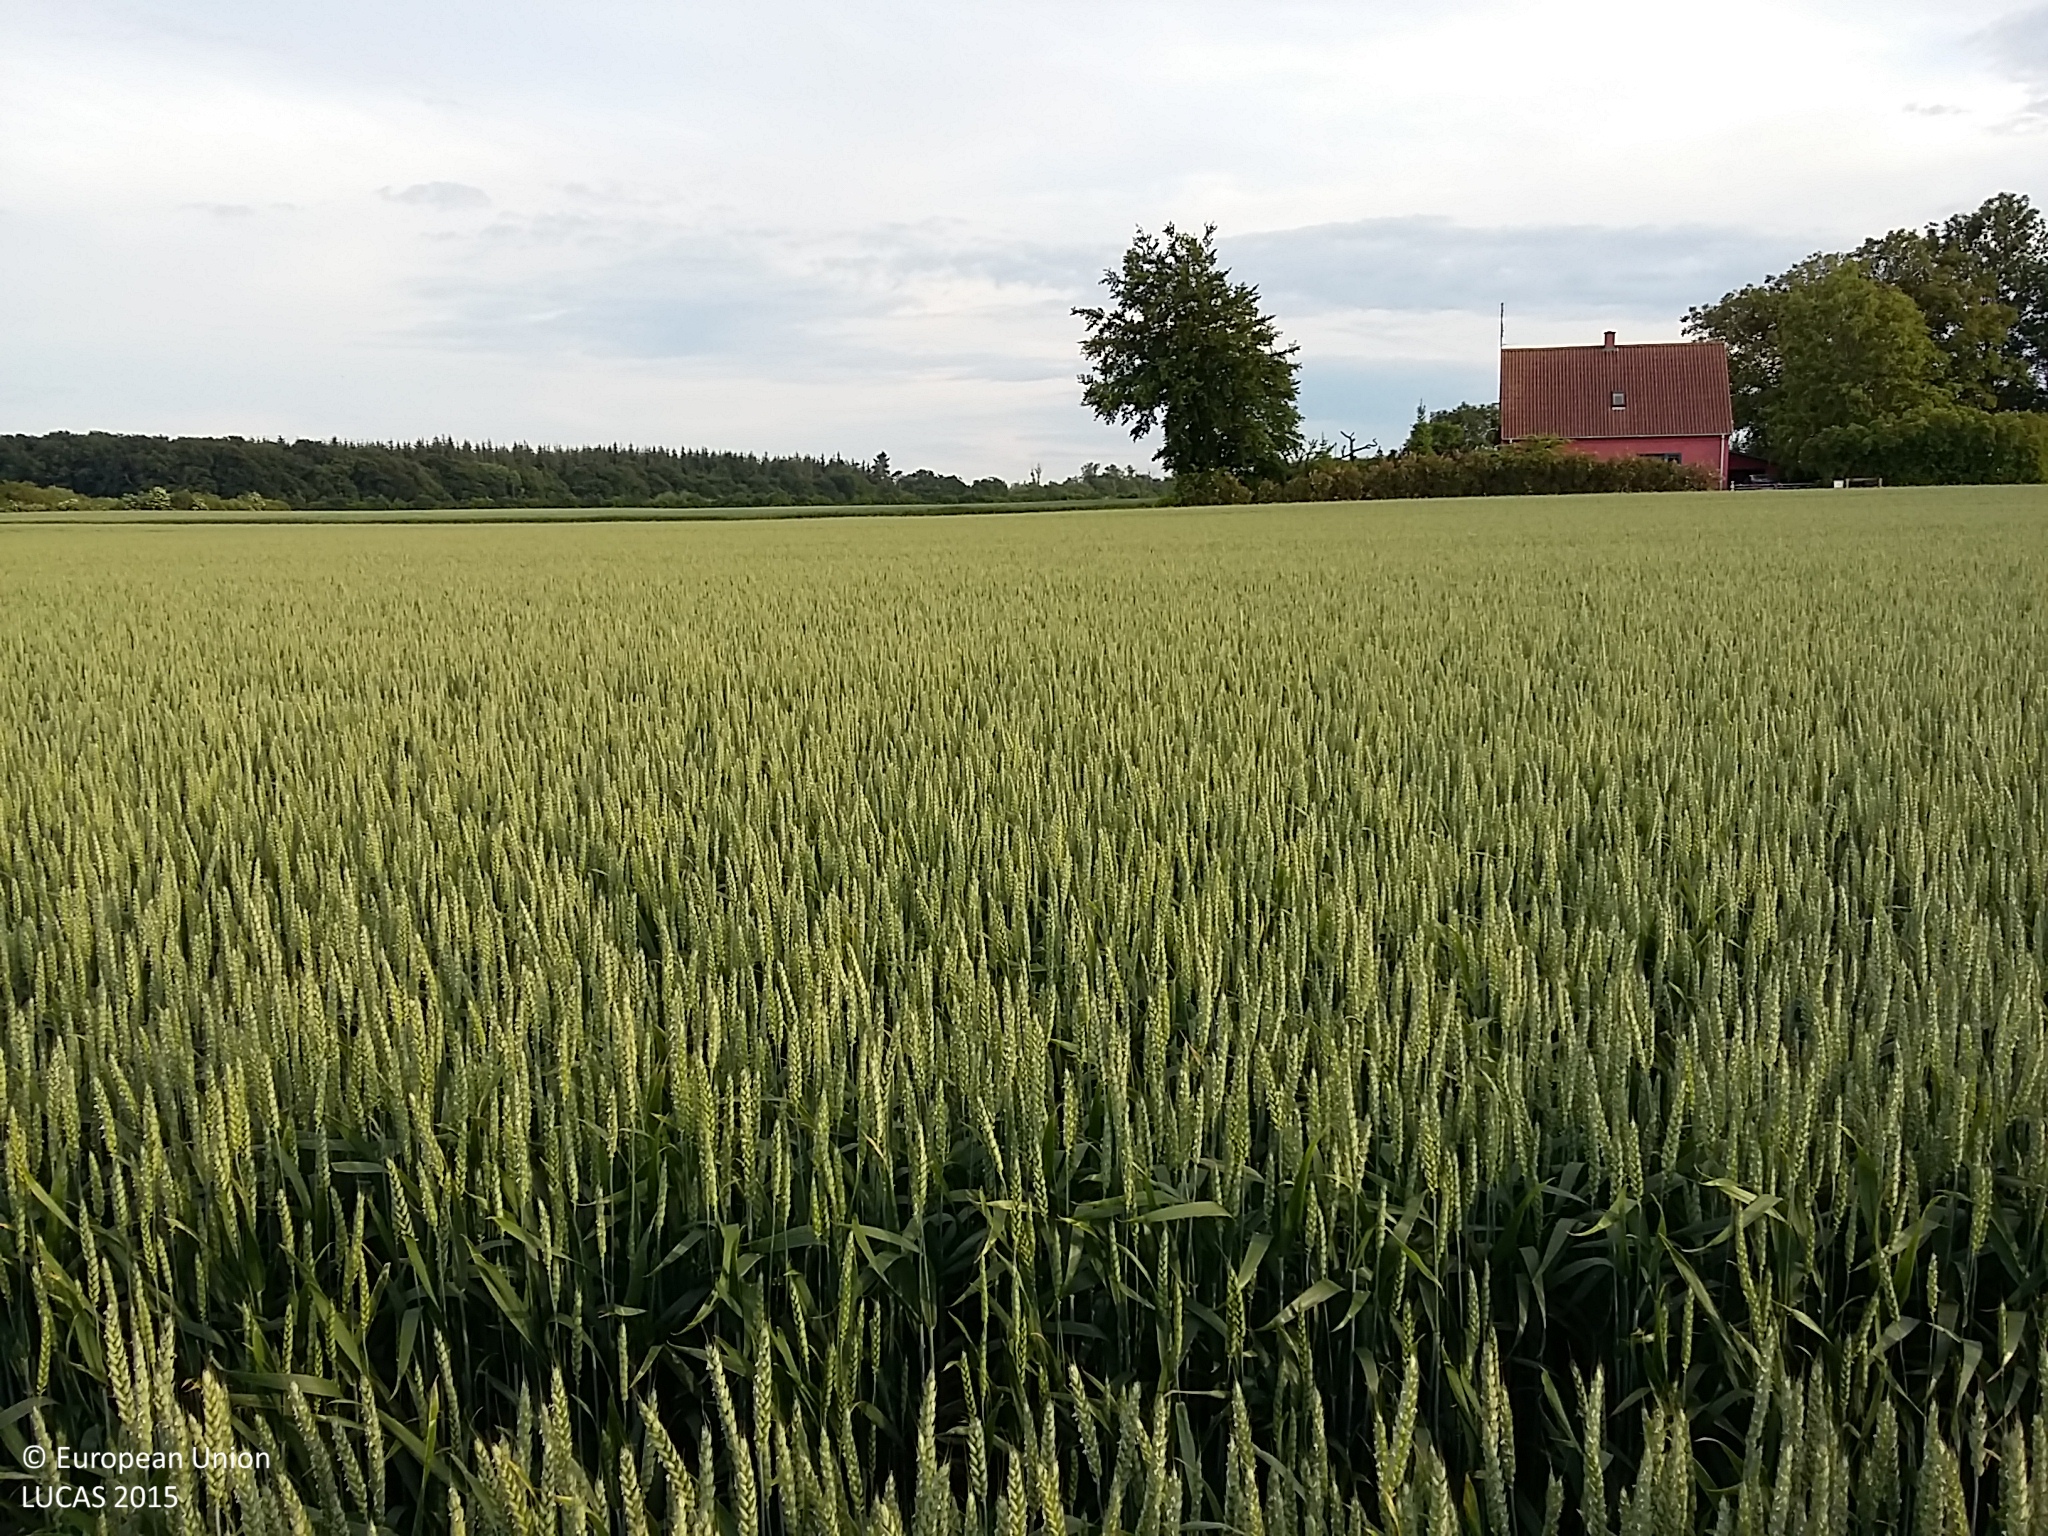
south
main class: Cropland
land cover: Common wheat
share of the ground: > 75 %
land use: Agriculture (excluding fallow land and kitchen gardens)
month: June
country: DK
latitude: 54.7774
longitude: 11.4449
